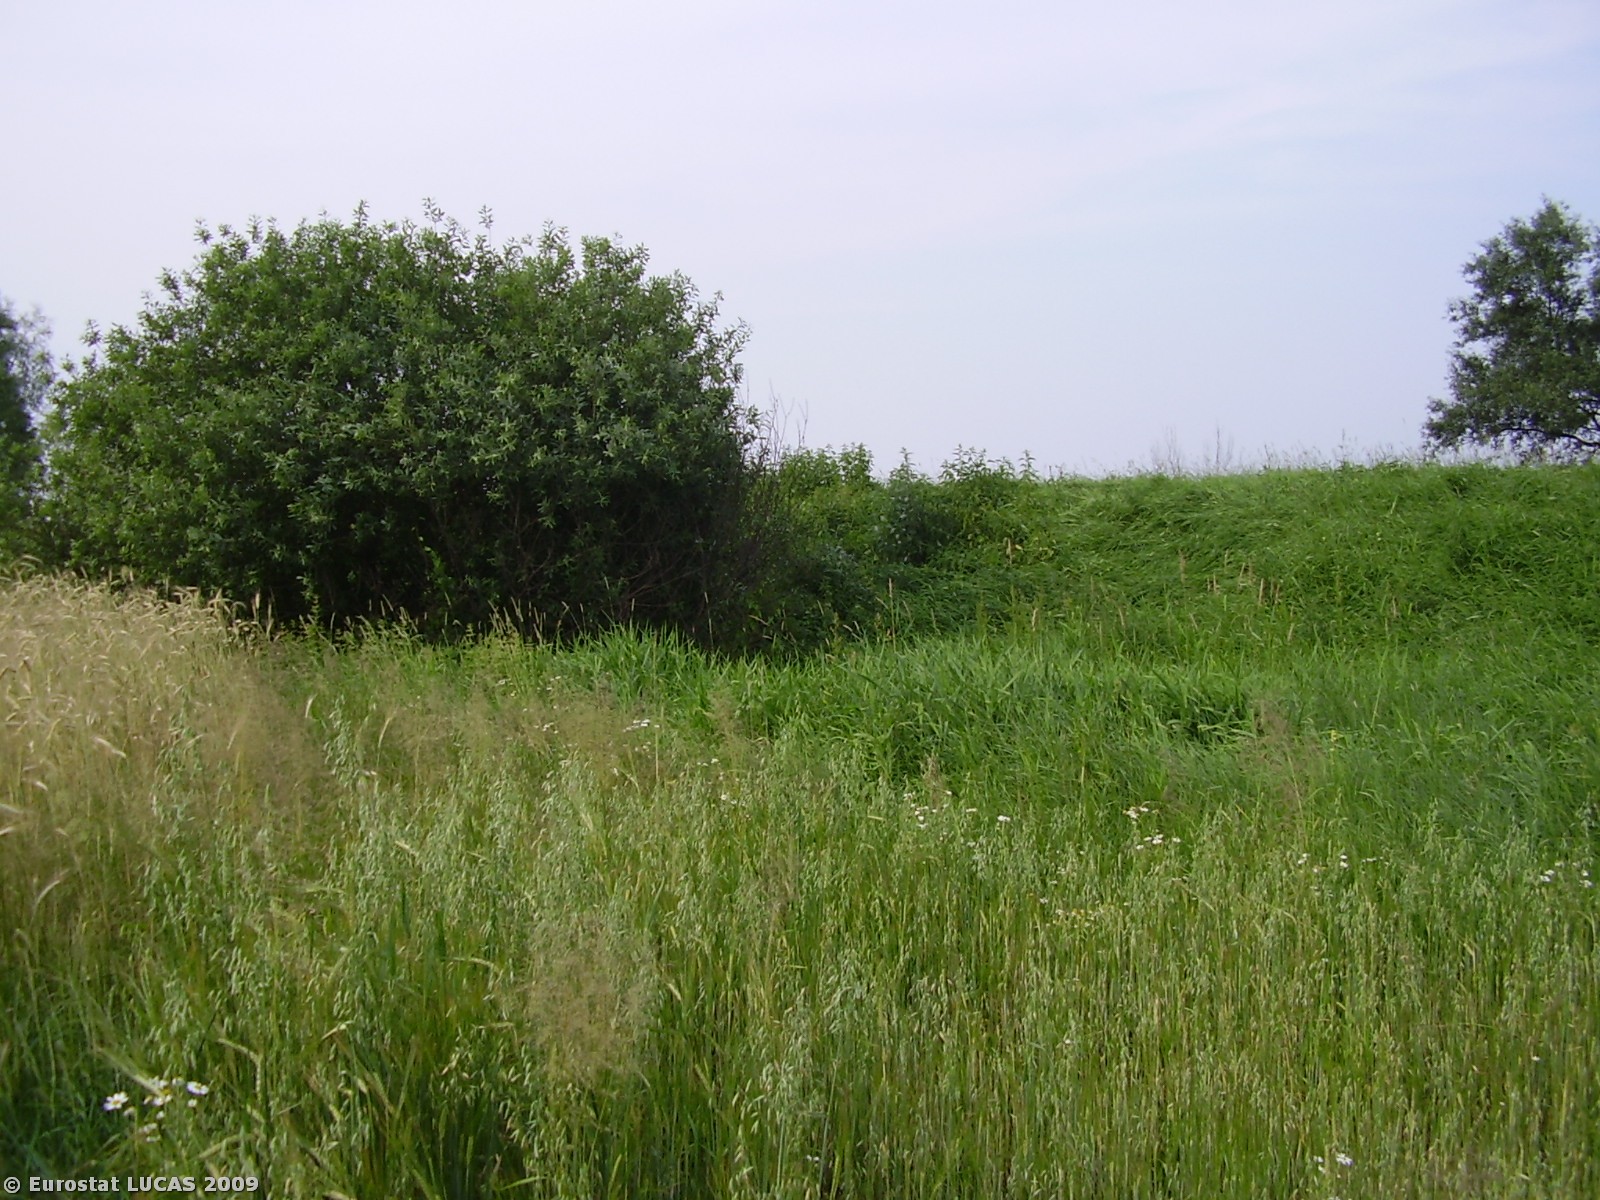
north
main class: Cropland
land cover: Rye
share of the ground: > 75 %
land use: Agriculture (excluding fallow land and kitchen gardens)
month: July
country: PL
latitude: 51.5671
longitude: 16.8331
